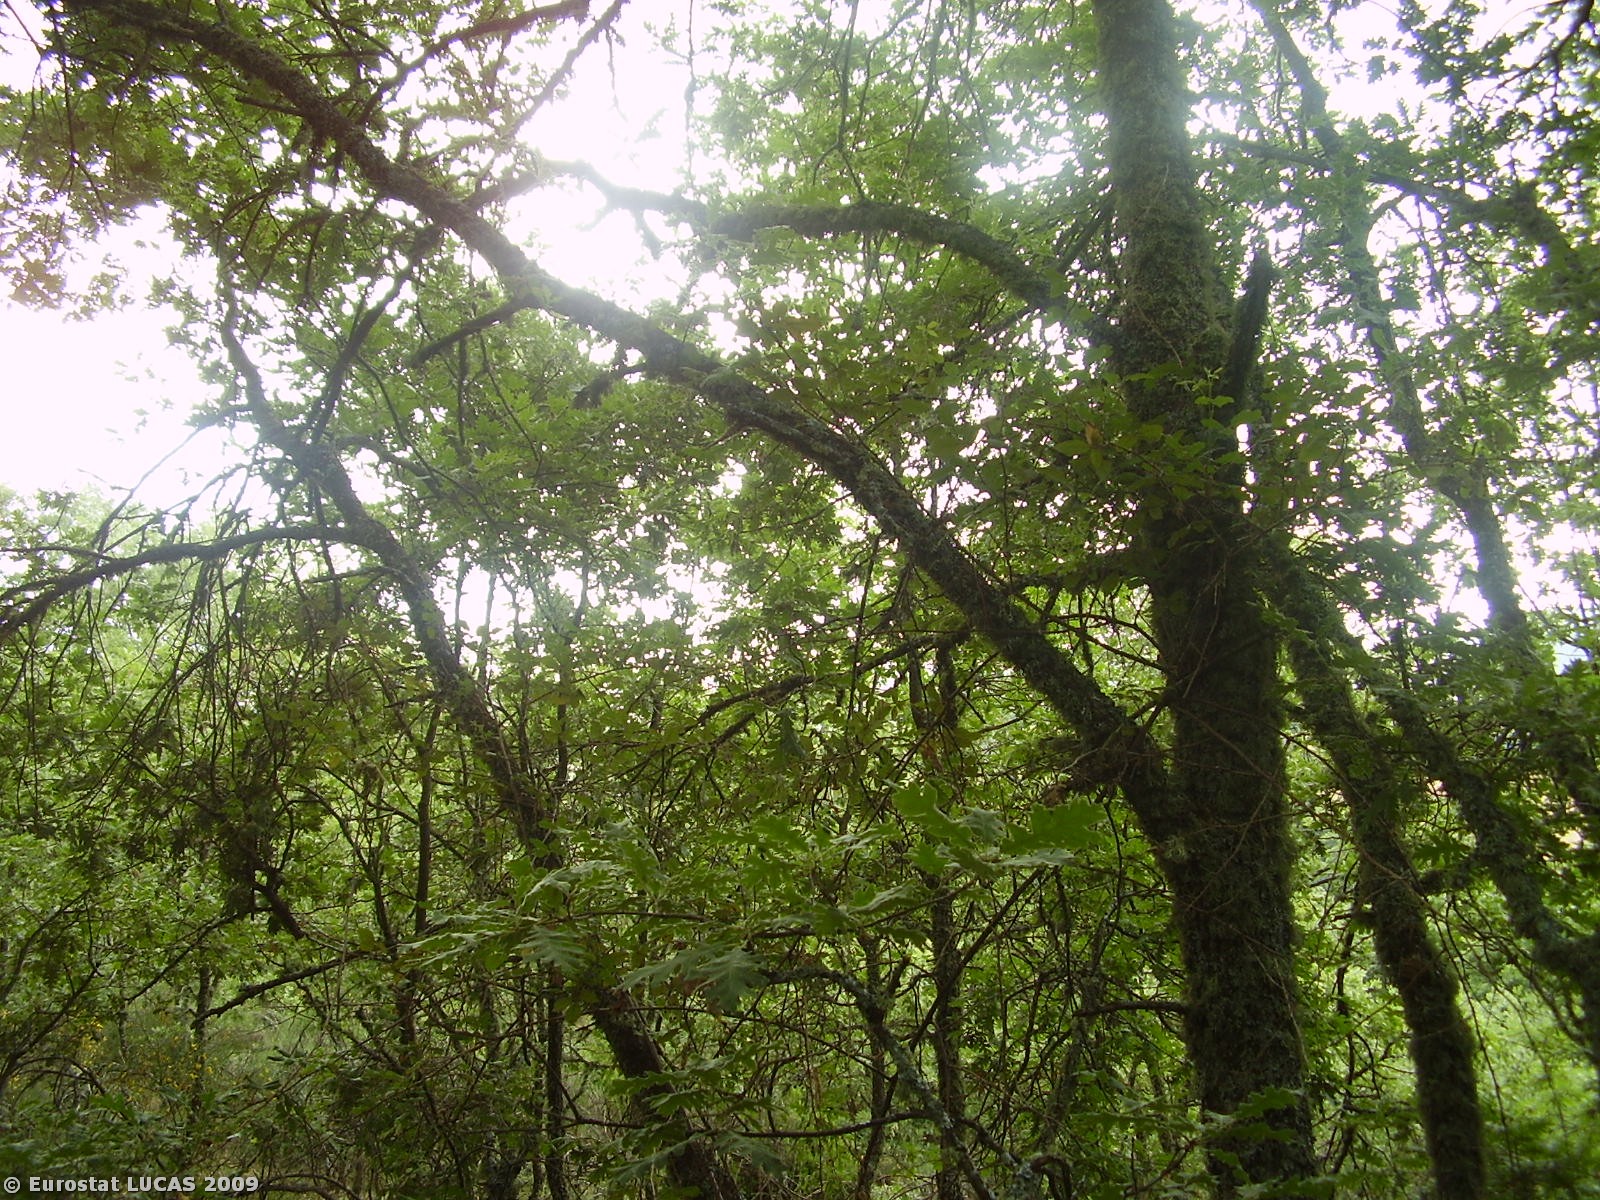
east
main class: Woodland
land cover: Broadleaved woodland
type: acidophilous oak and oak-birch forest
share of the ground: > 75 %
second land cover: Spontaneously vegetated surfaces
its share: 25 - 50 %
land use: Forestry
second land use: Nature reserves
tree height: > 5 m
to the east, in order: Broadleaved woodland; Spontaneously vegetated surfaces; Broadleaved woodland; Dry stone walls; Broadleaved woodland; Spontaneously vegetated surfaces; Tracks; Dry stone walls; Abandoned hedges; Bare land; Broadleaved woodland; Fences; Spontaneously vegetated surfaces
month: June
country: PT
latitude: 41.7122
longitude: -6.8317
